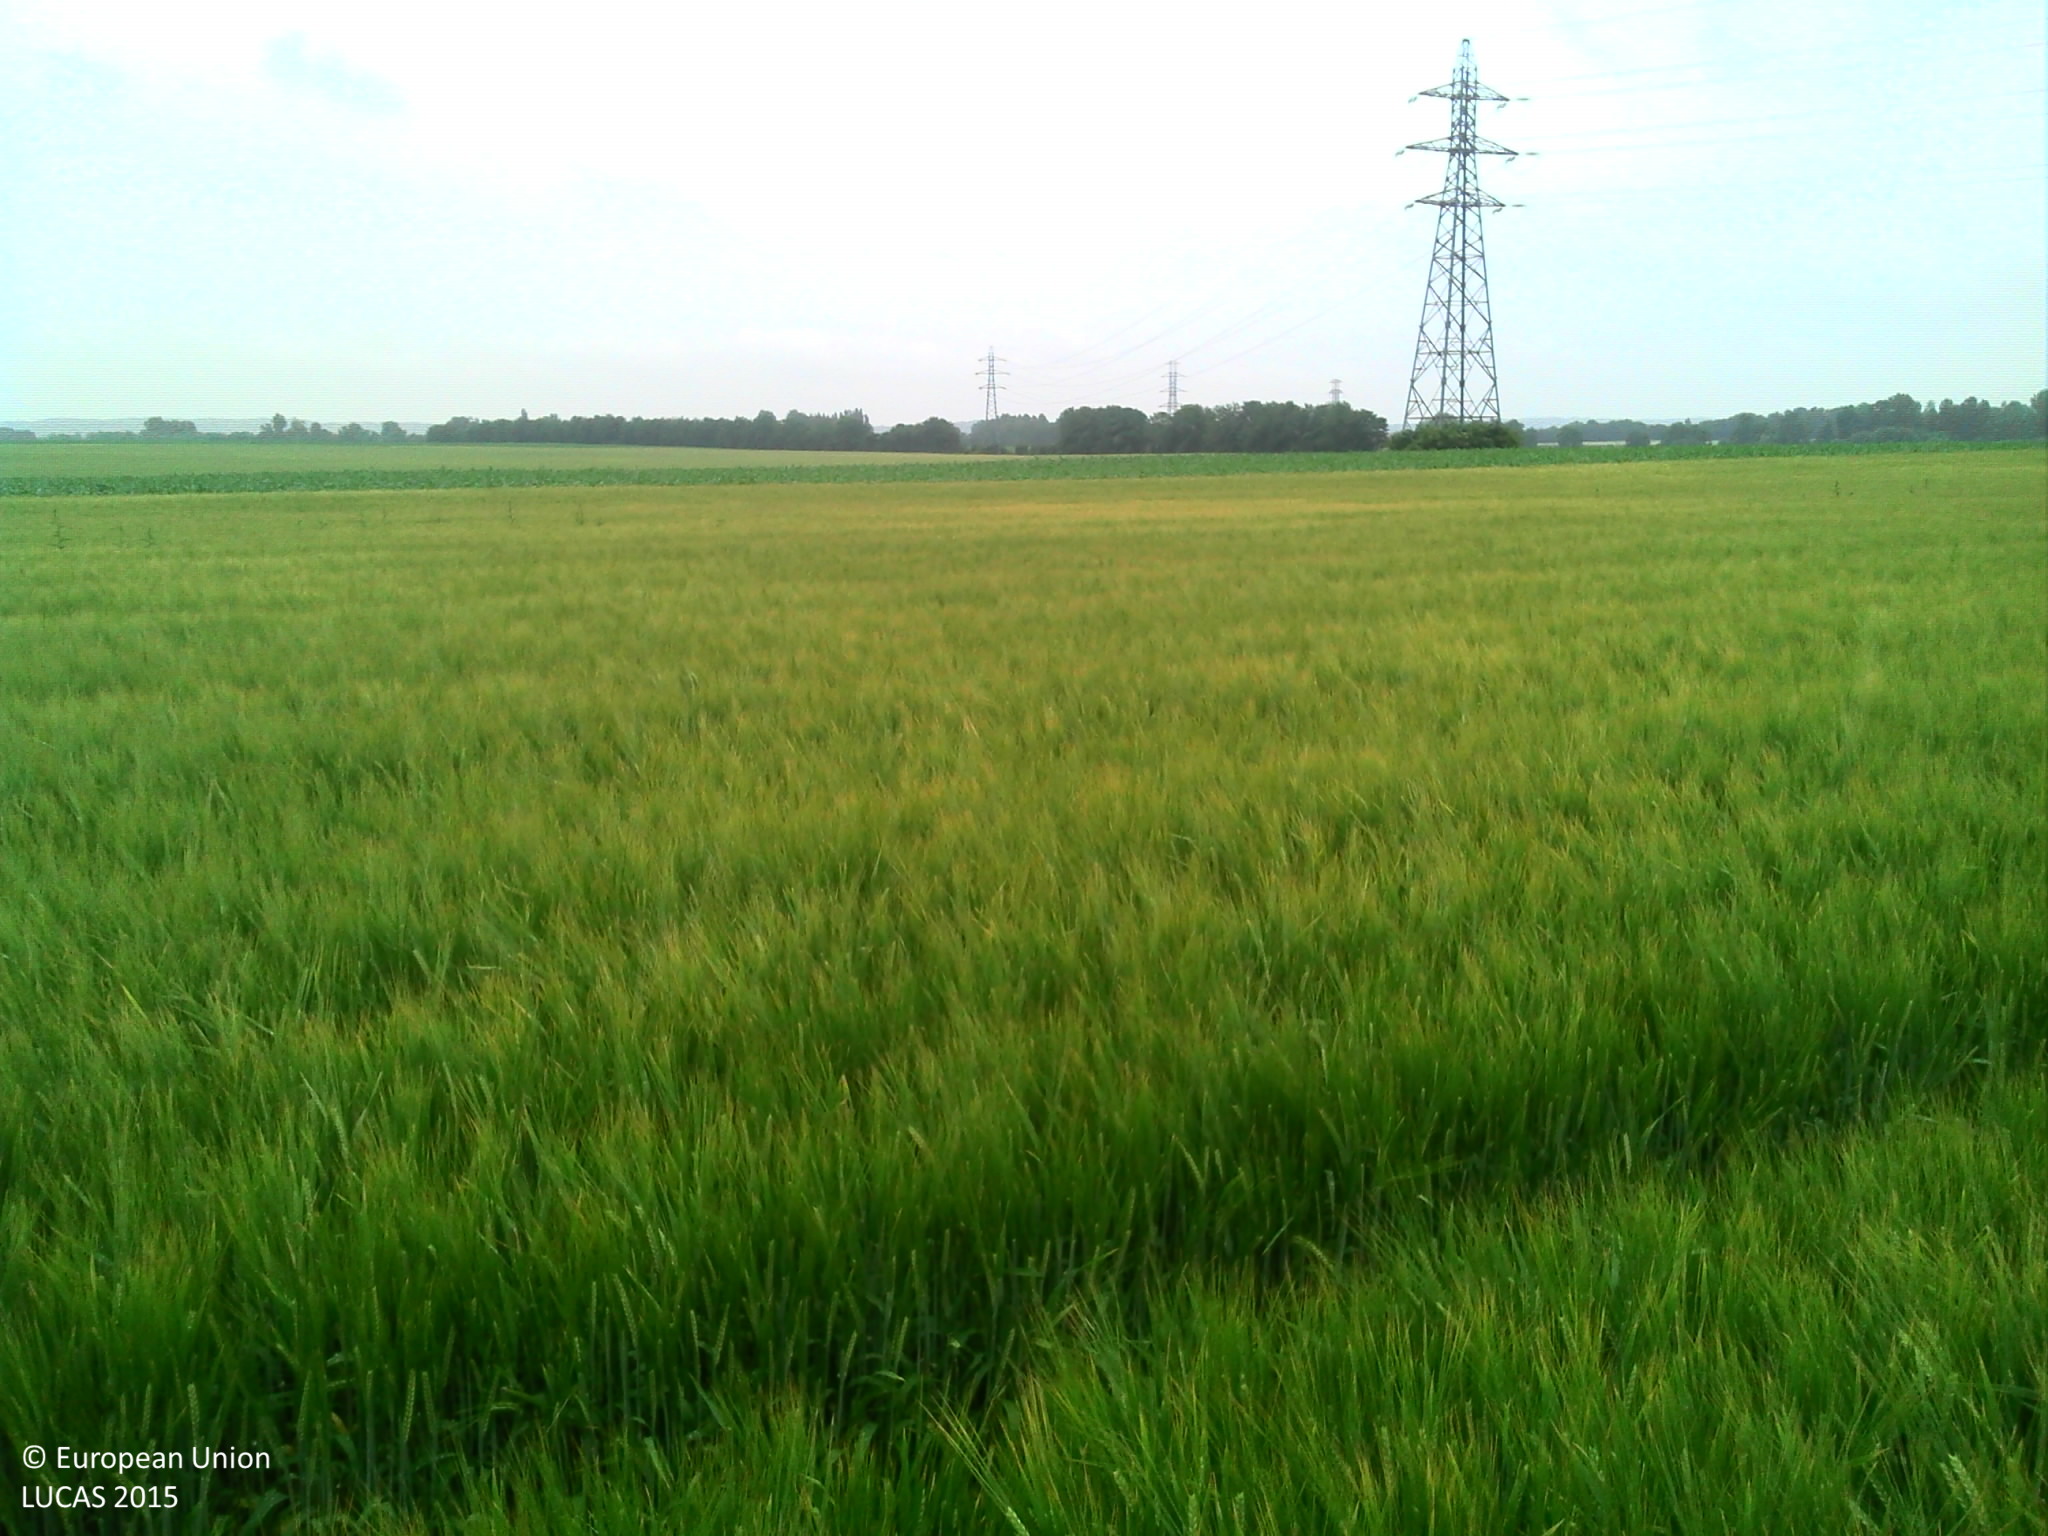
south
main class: Cropland
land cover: Barley
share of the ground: > 75 %
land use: Agriculture (excluding fallow land and kitchen gardens)
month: June
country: FR
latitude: 49.5935
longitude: 3.6711
